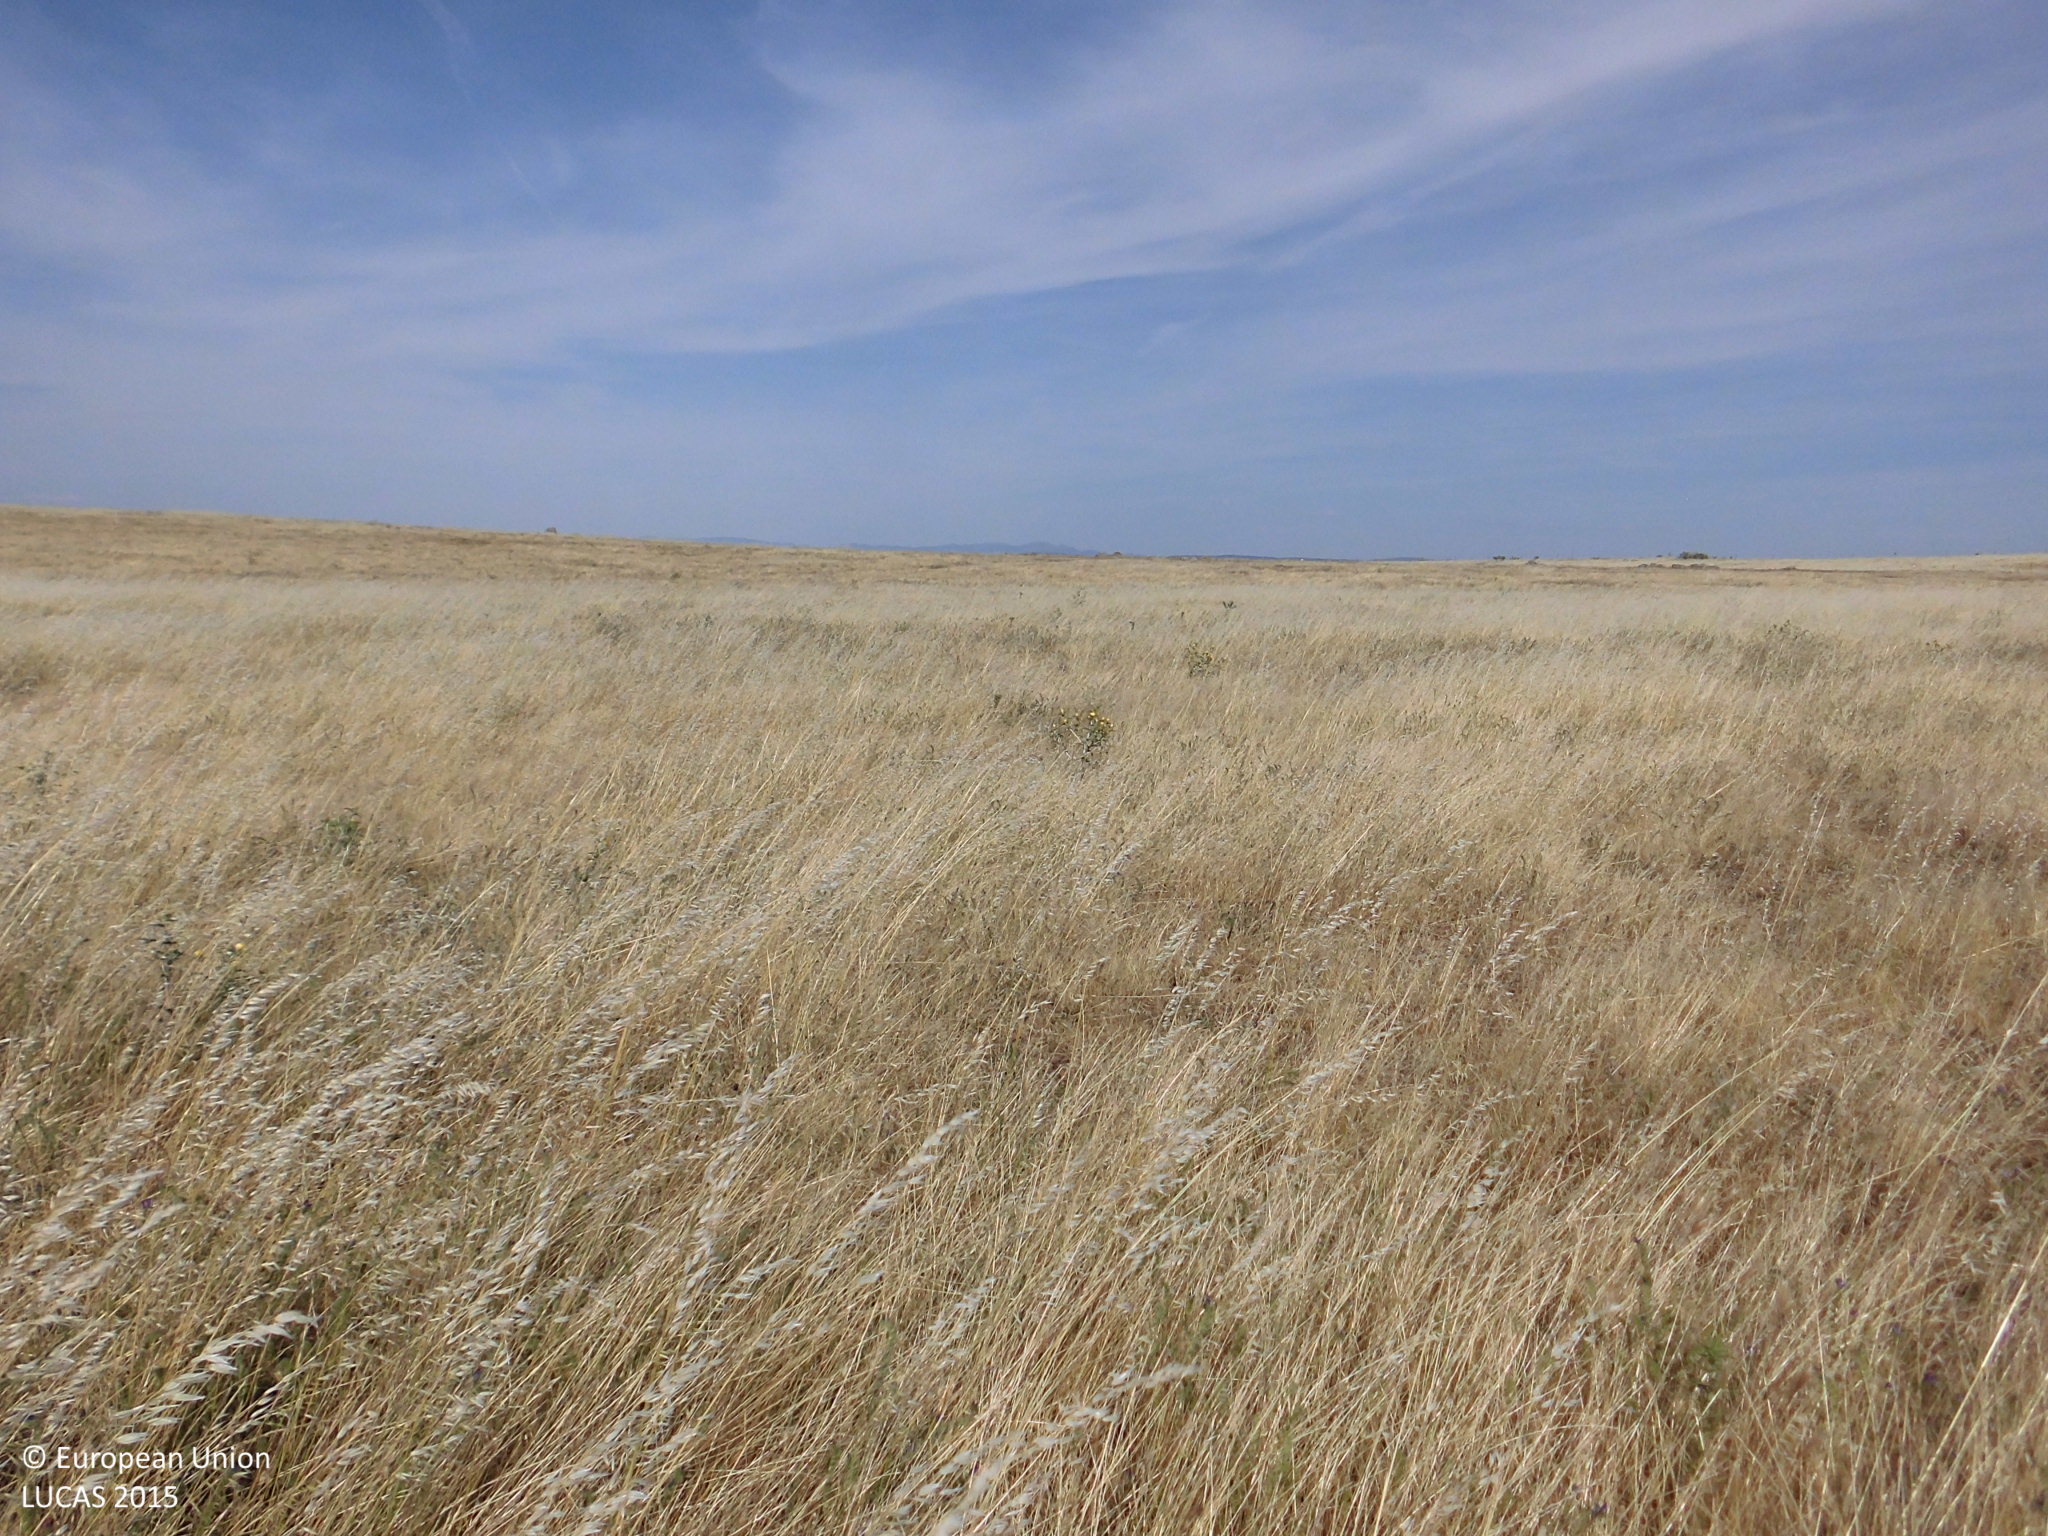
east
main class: Grassland
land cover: Grassland without tree/shrub cover
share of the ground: > 75 %
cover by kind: herbaceous plants 100 %
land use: Agriculture (excluding fallow land and kitchen gardens)
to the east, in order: Grassland without tree/shrub cover; Tracks; Grassland without tree/shrub cover
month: May
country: ES
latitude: 39.4962
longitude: -6.0035
